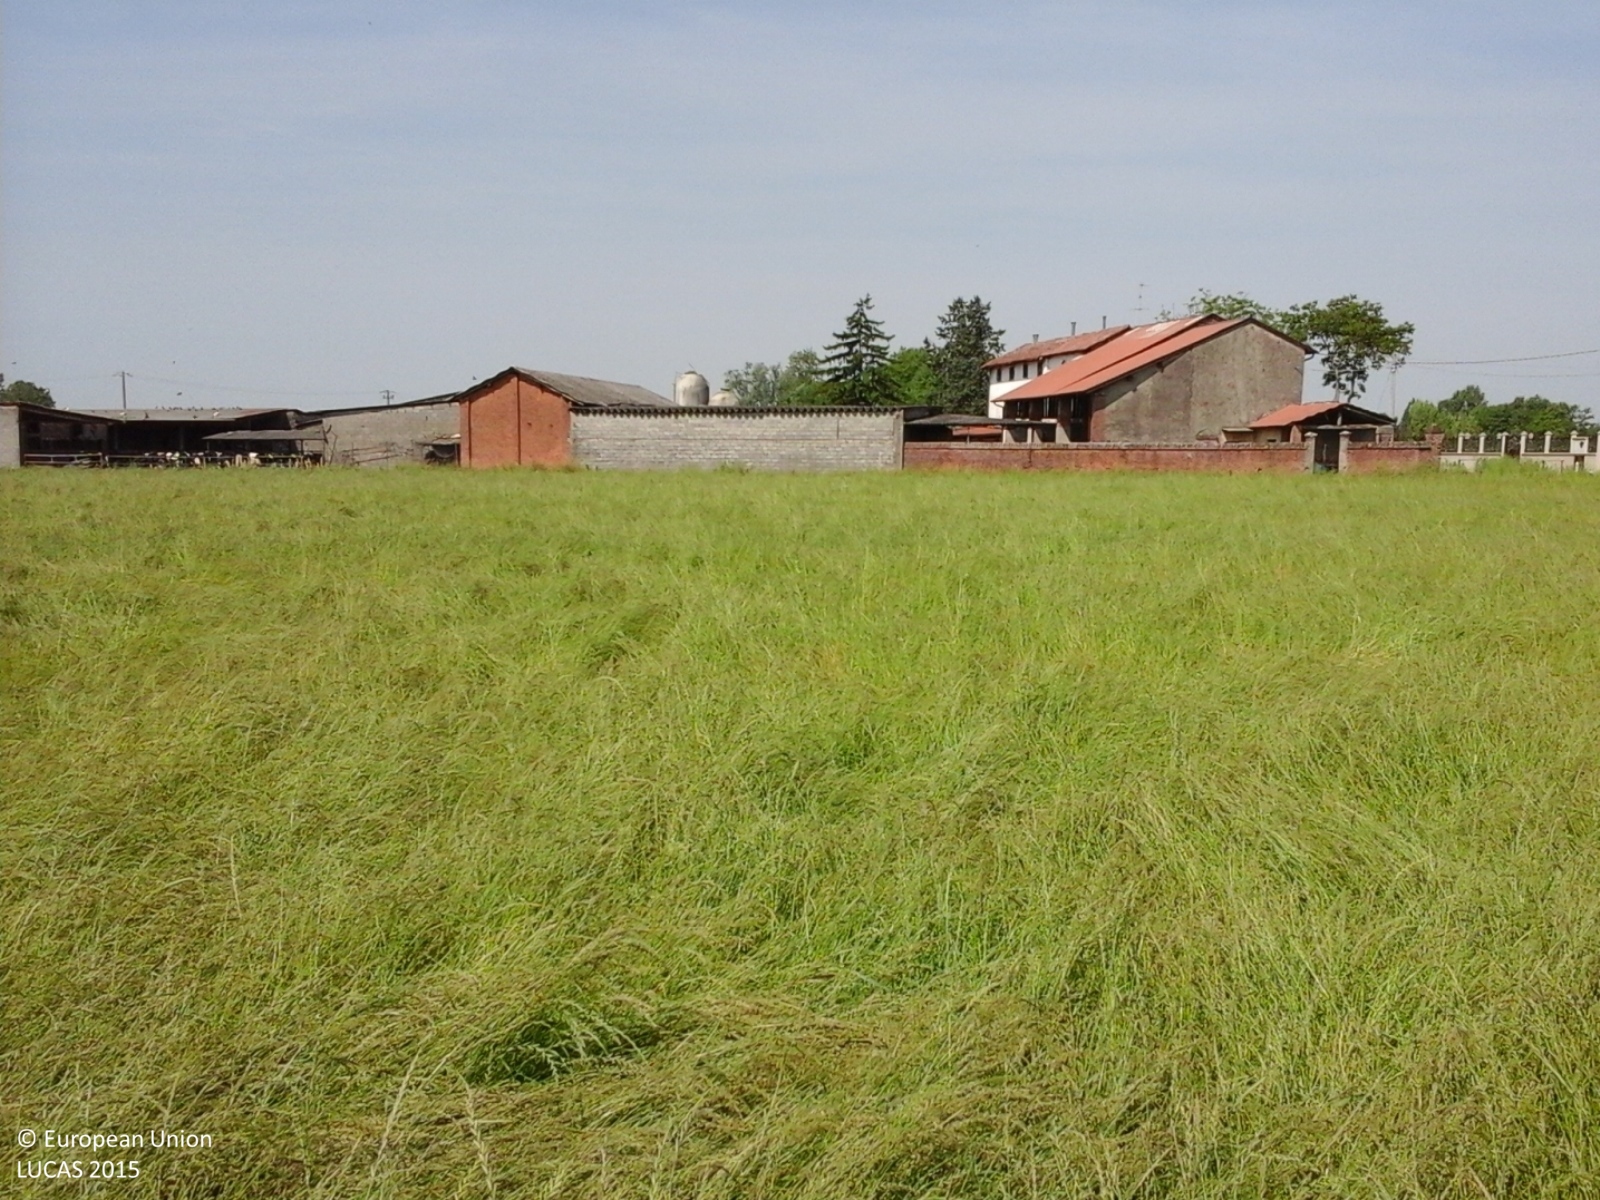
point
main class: Cropland
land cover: Temporary grasslands
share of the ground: > 75 %
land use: Agriculture (excluding fallow land and kitchen gardens)
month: May
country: IT
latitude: 45.3962
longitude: 9.8597
